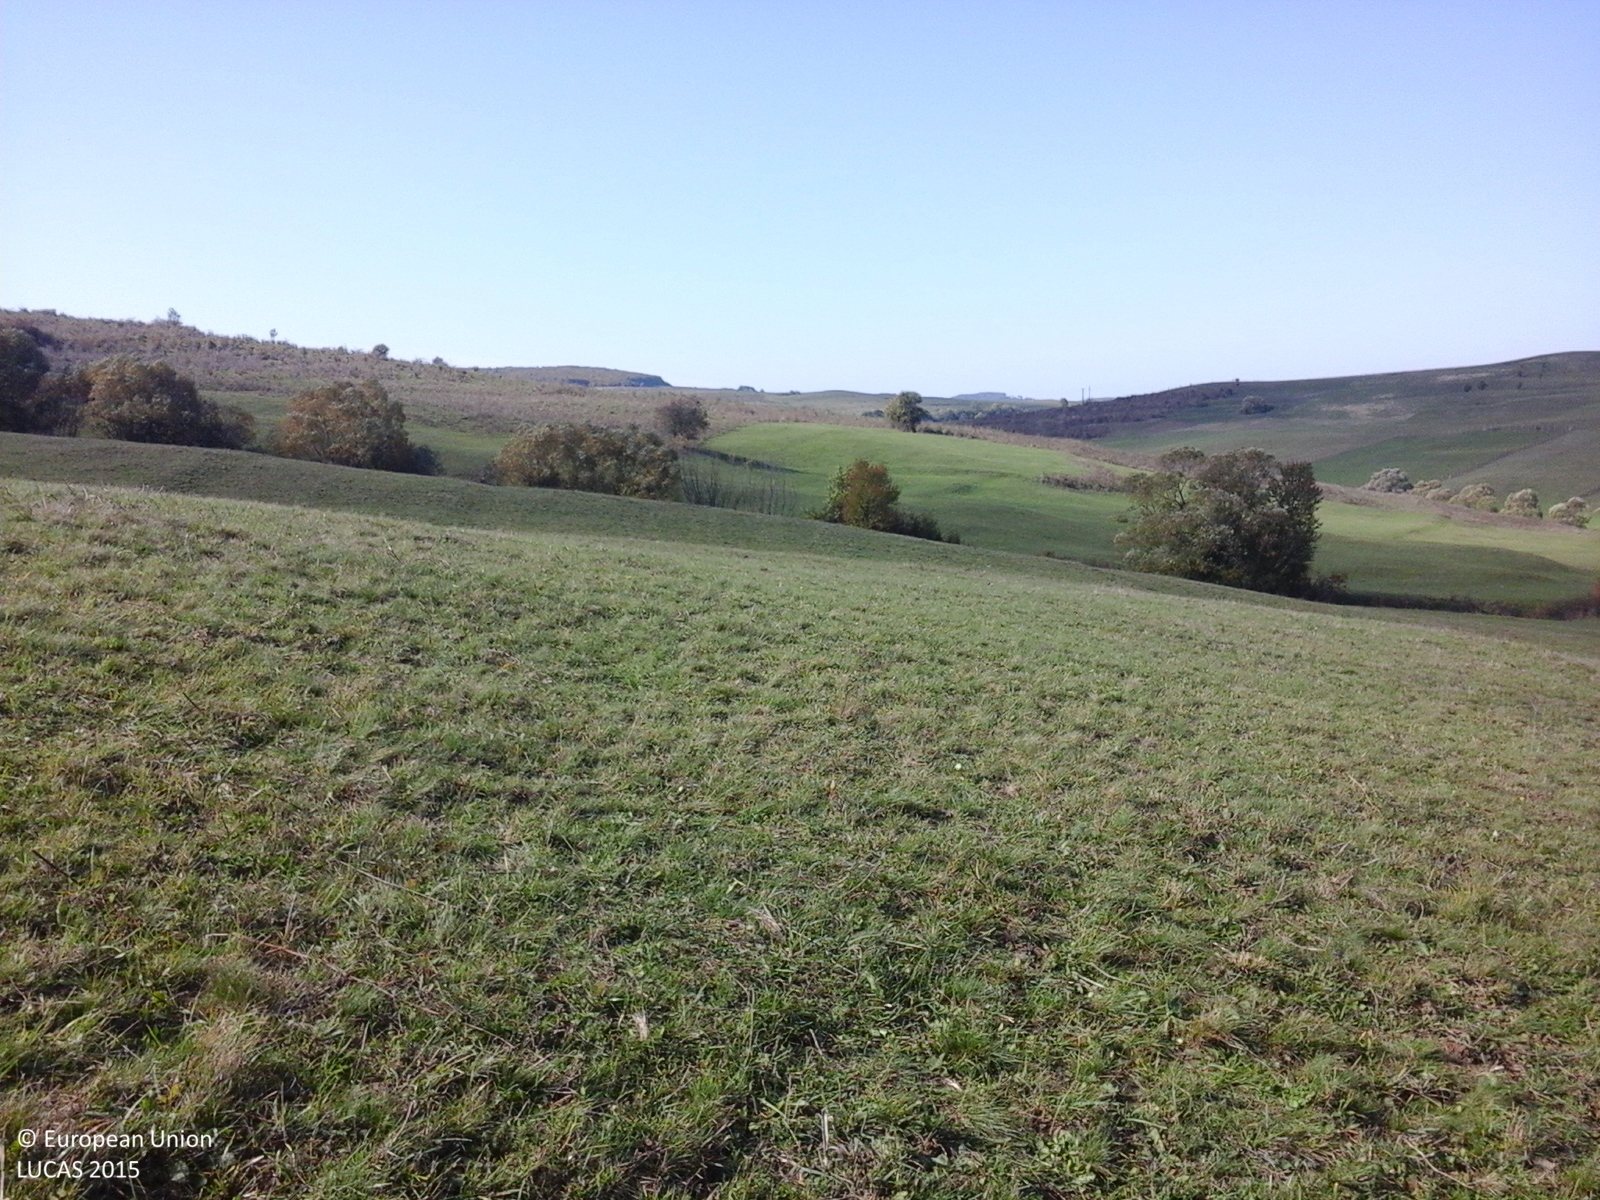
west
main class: Grassland
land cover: Grassland without tree/shrub cover
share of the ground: > 75 %
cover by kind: herbaceous plants 100 %
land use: Agriculture (excluding fallow land and kitchen gardens)
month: October
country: RO
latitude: 46.4672
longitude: 25.0613
